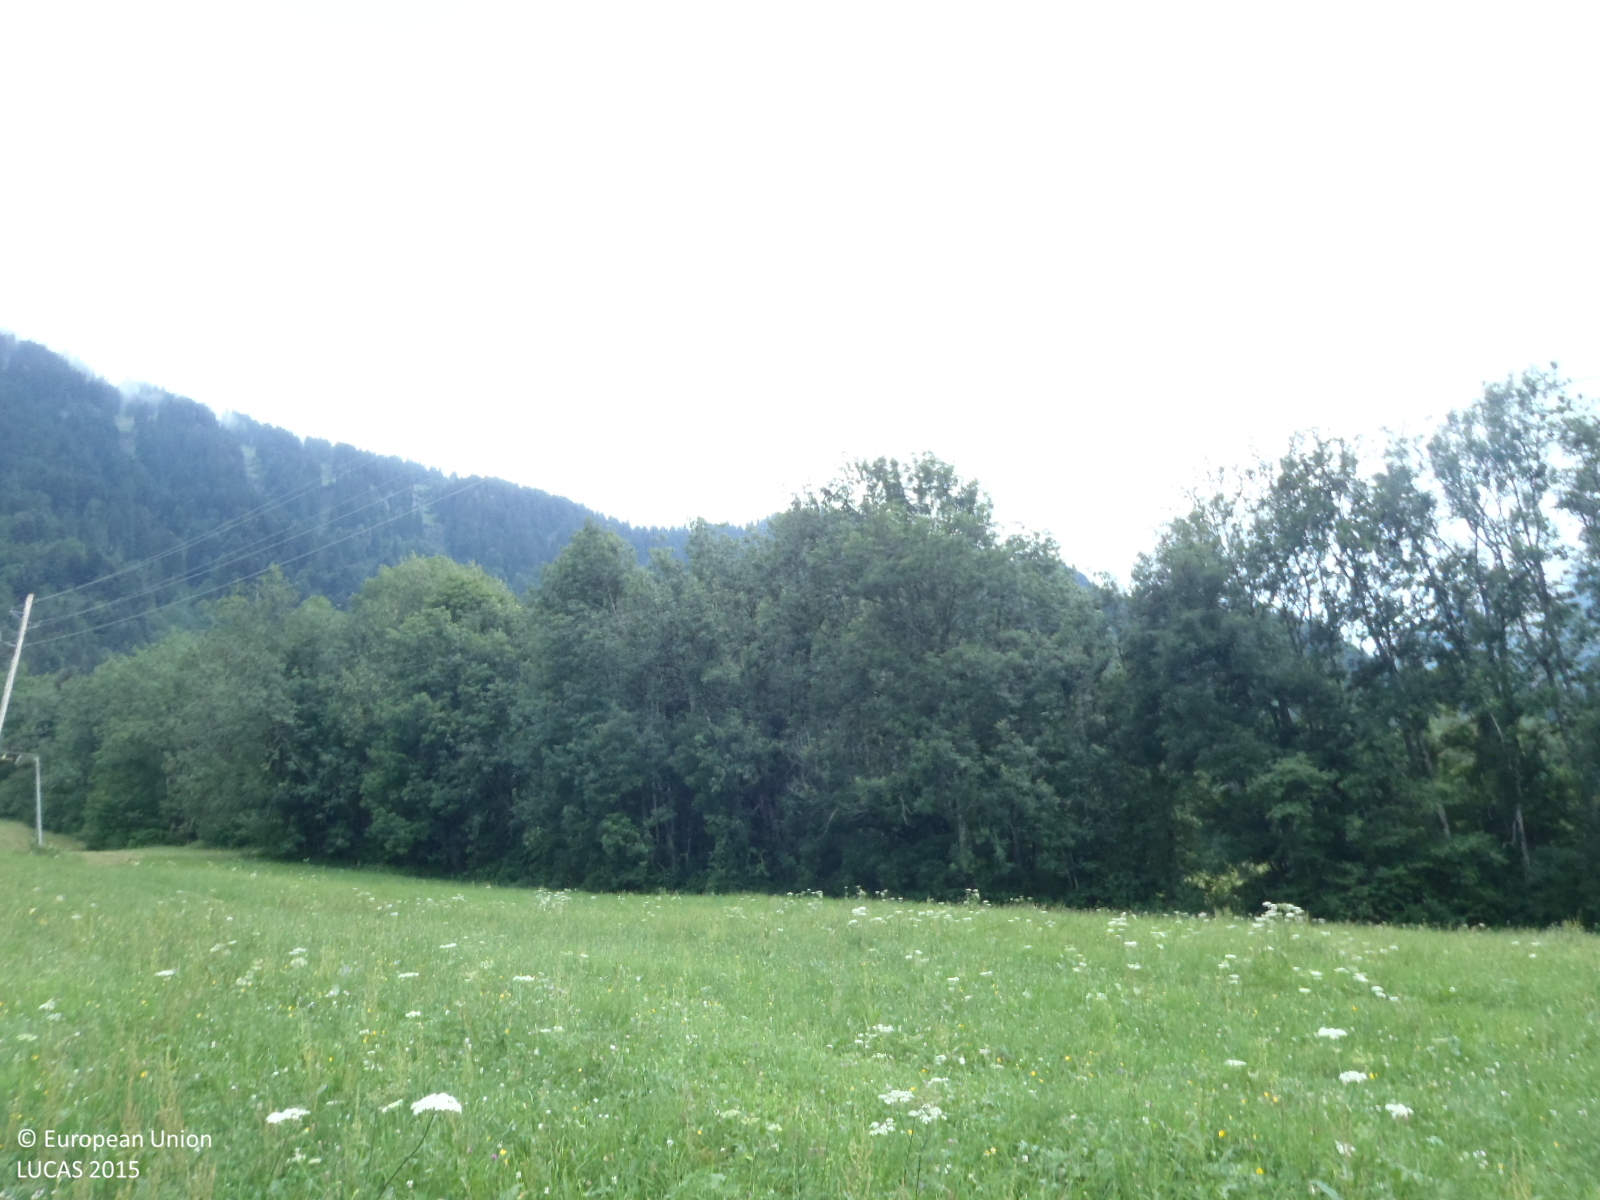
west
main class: Grassland
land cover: Grassland without tree/shrub cover
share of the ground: > 75 %
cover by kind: herbaceous plants 100 %
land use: Agriculture (excluding fallow land and kitchen gardens)
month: July
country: AT
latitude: 47.1791
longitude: 9.6705
